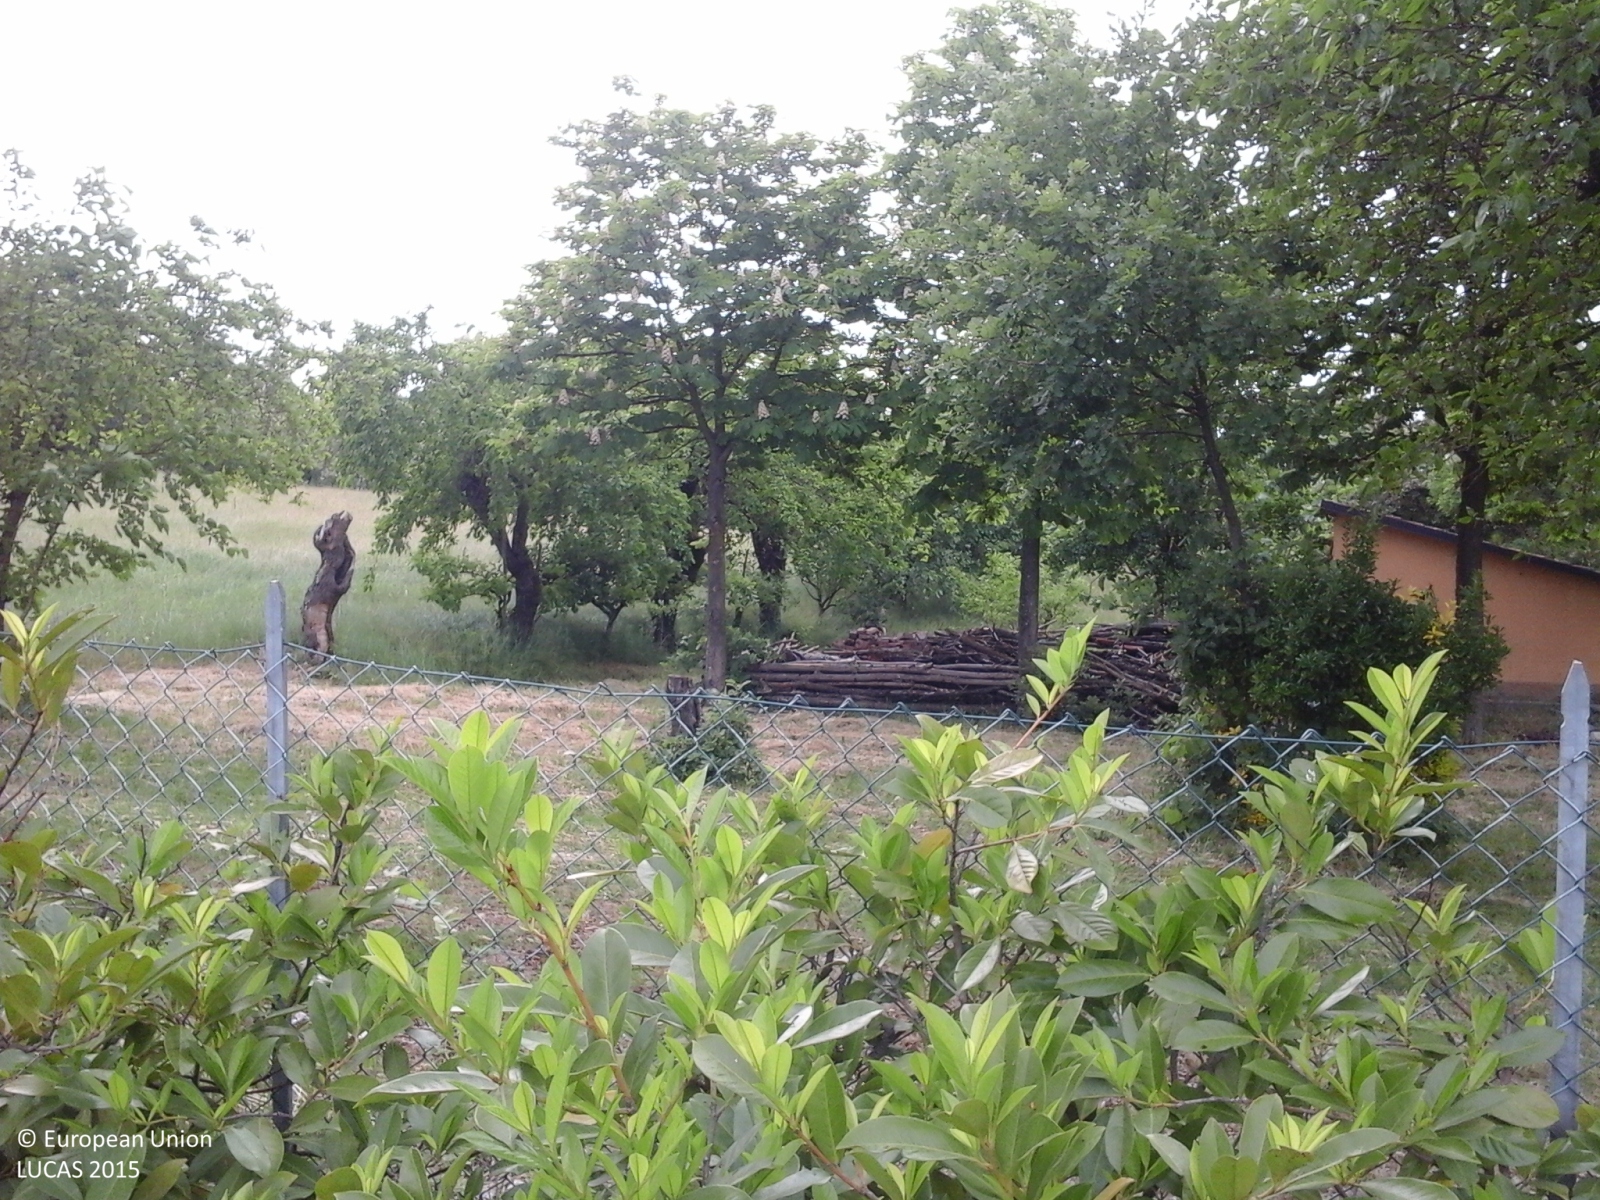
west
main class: Woodland
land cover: Broadleaved woodland
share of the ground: > 75 %
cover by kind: broadleaved forest trees 80 %, herbaceous plants 20 %
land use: Residential
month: May
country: IT
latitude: 44.5825
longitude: 10.7163
